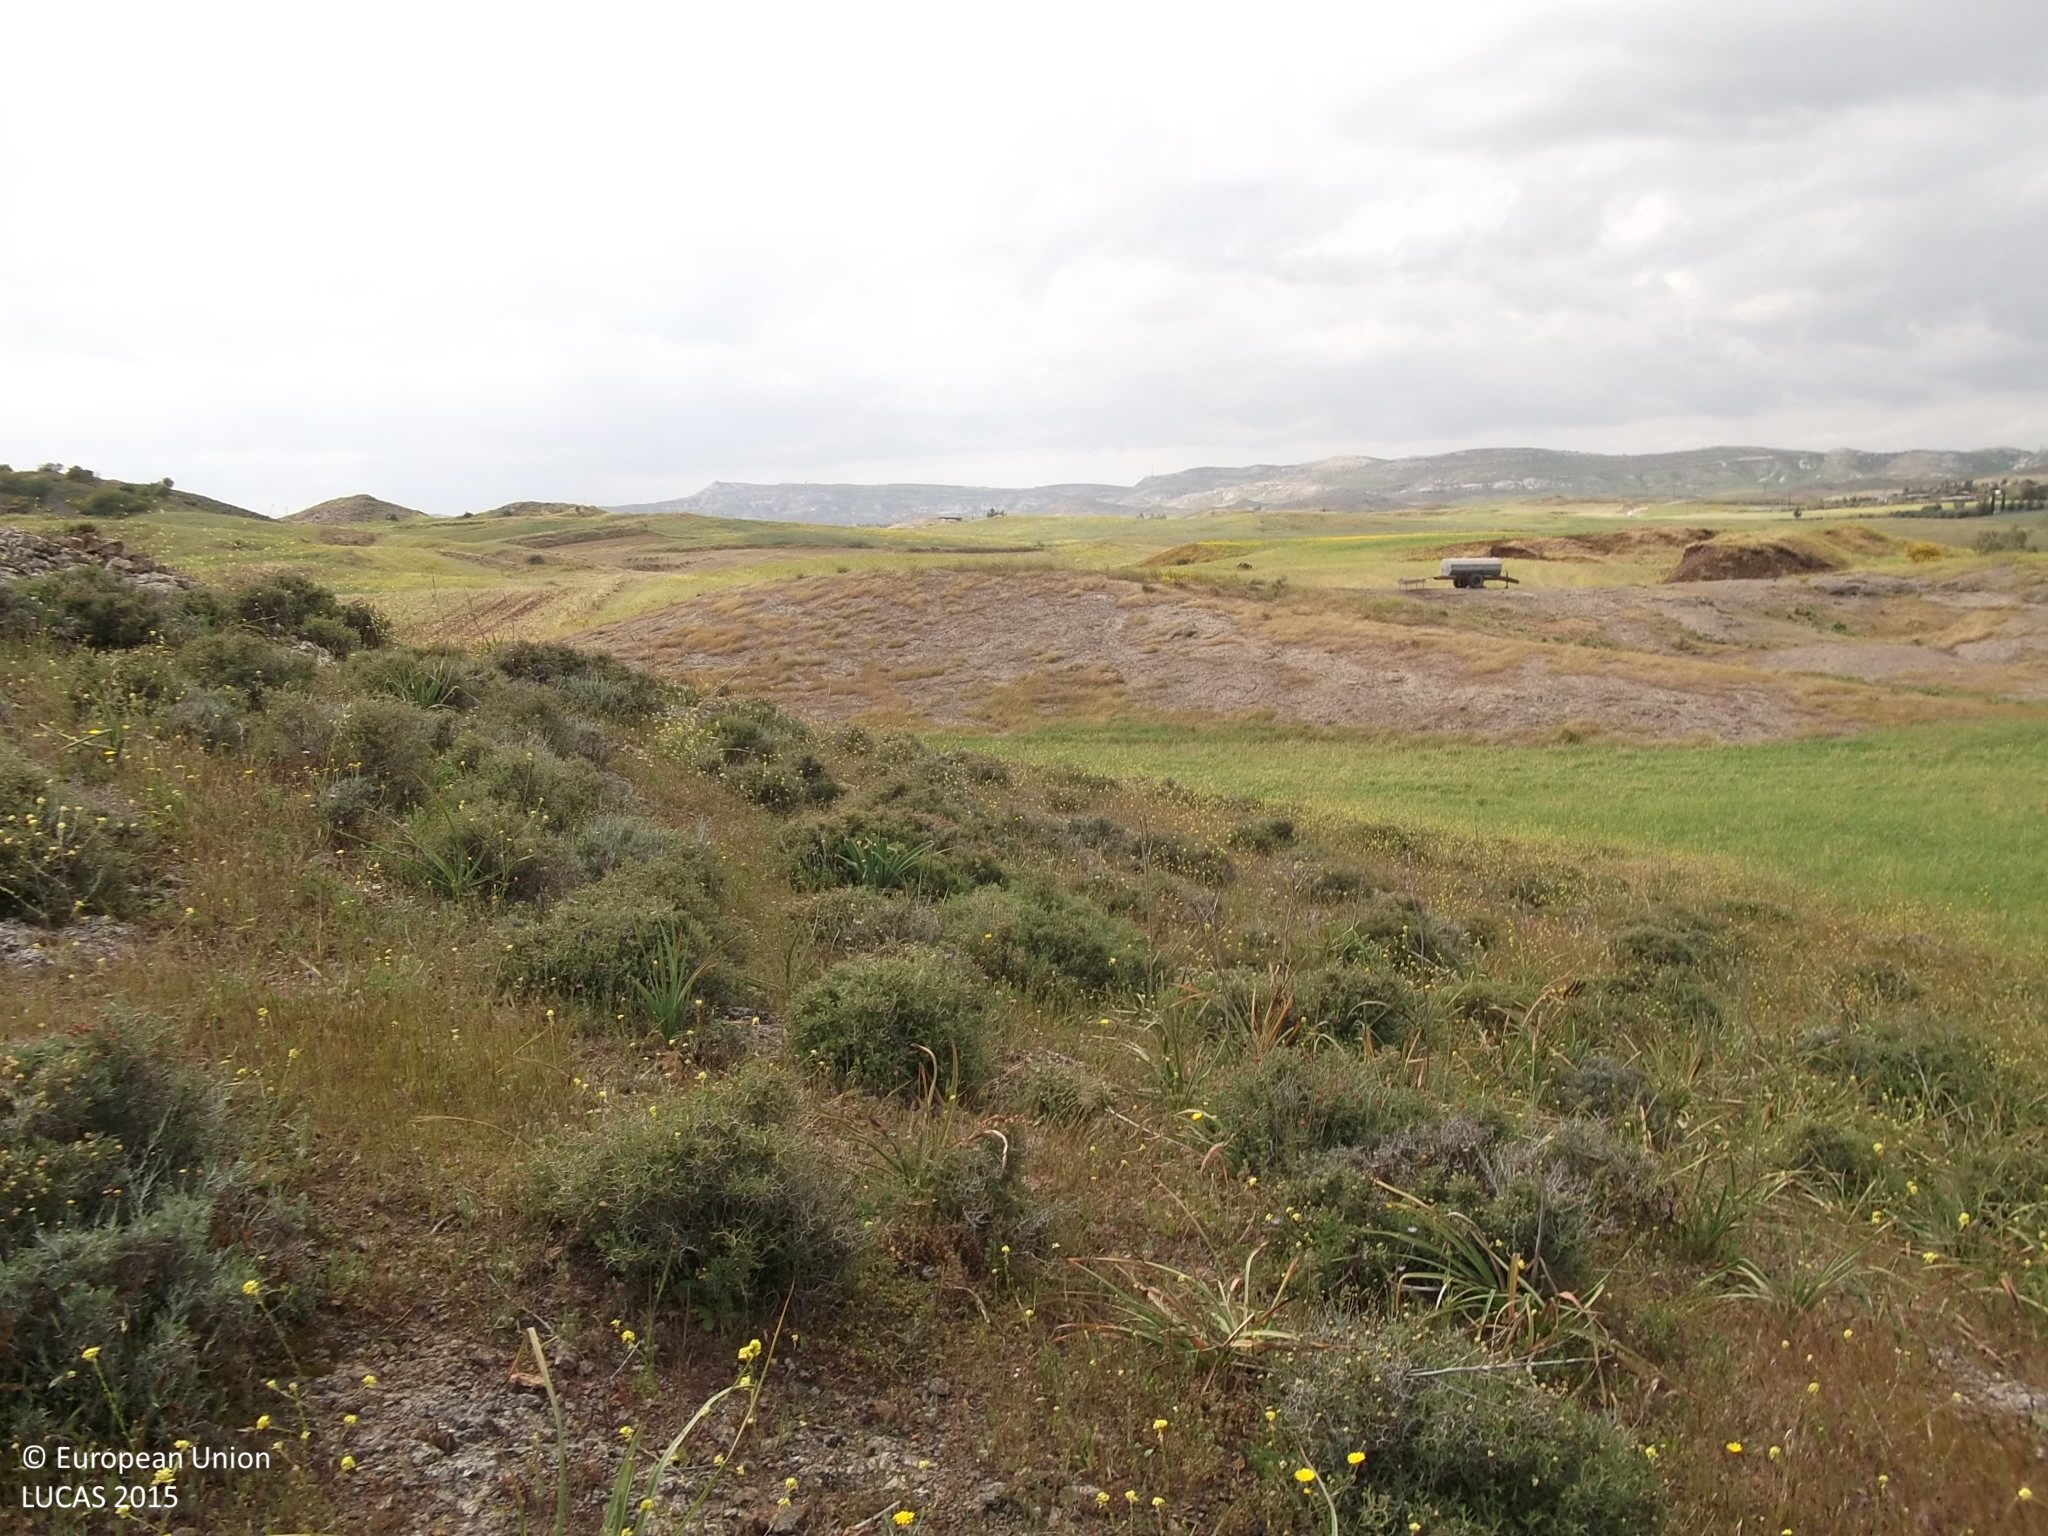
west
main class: Shrubland
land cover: Shrubland without tree cover
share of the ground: > 75 %
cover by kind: shrubs 70 %, herbaceous plants 20 %, unconsolidated bare surface 10 %
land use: Semi-natural and natural areas not in use
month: April
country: CY
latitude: 35.0096
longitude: 33.6164
